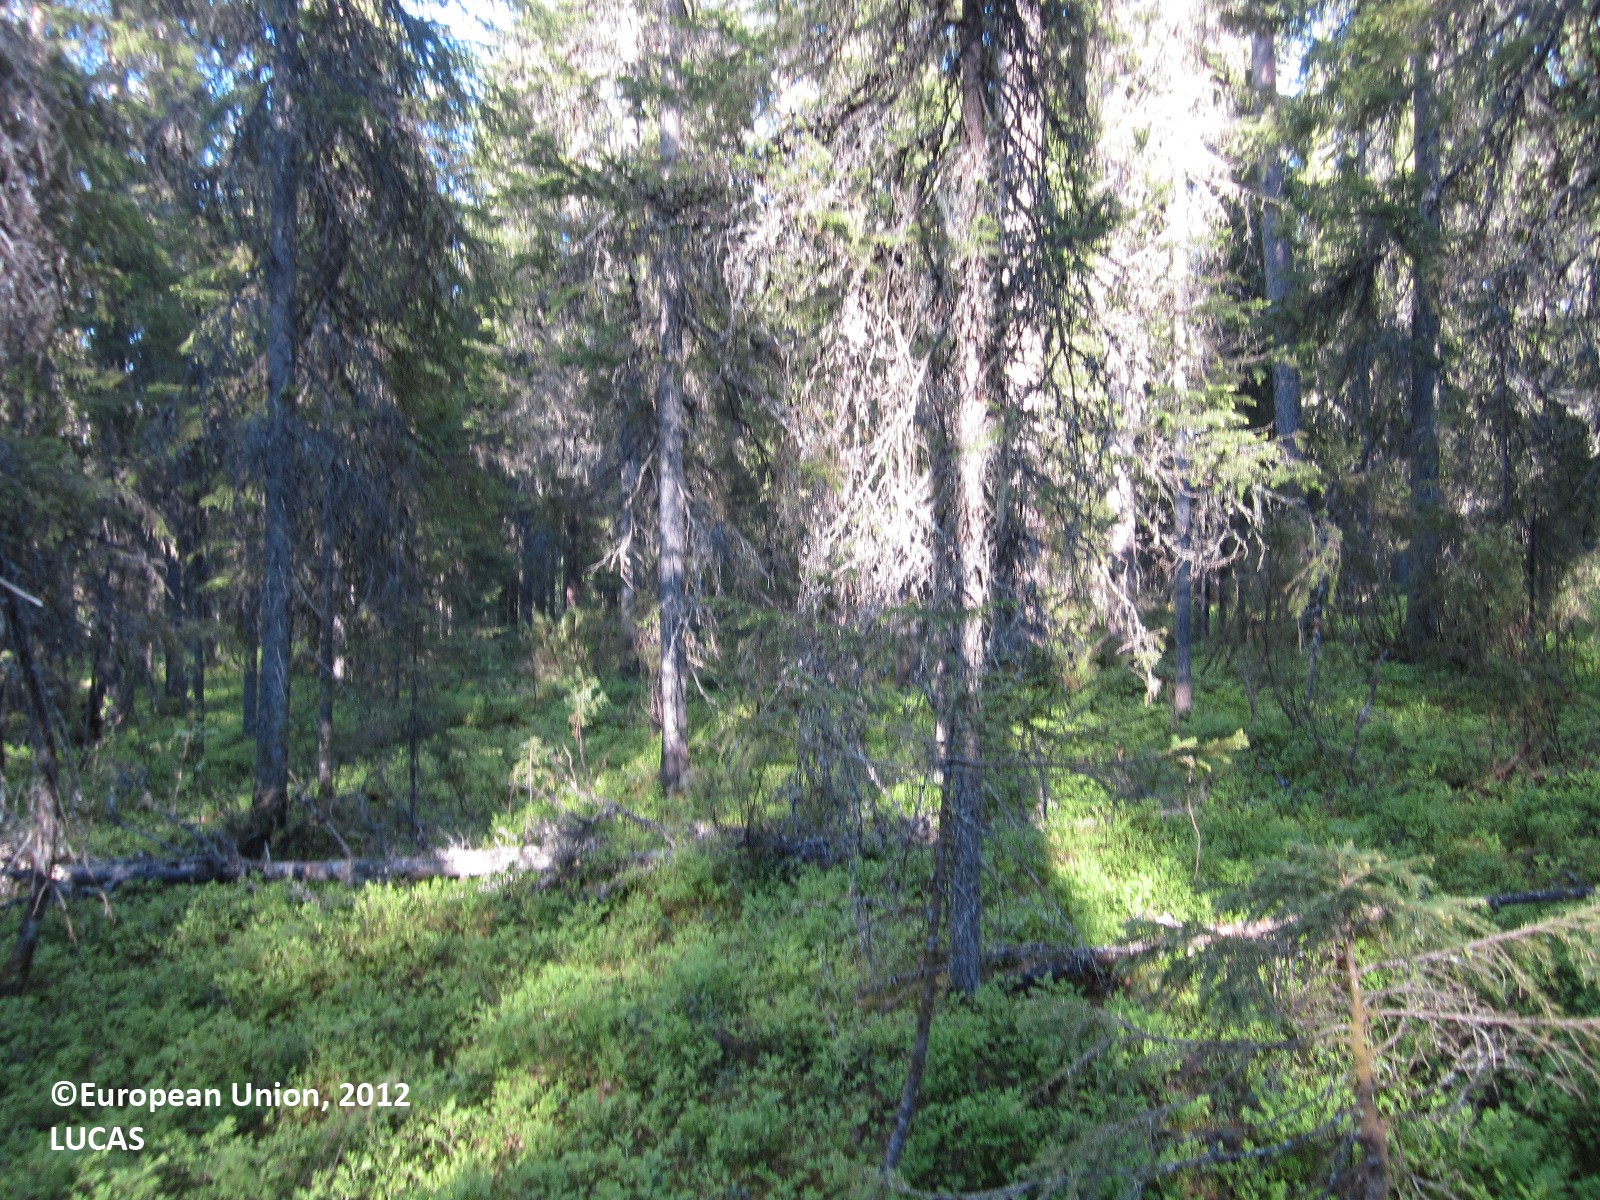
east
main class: Woodland
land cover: Spruce dominated coniferous woodland
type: boreal forest
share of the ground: > 75 %
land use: Forestry
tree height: > 5 m
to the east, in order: Spruce dominated coniferous woodland; Shrubland with sparse tree cover; Ditches and canals; Abandoned hedges; Paved roads, cycling and walking lanes; Abandoned hedges; Ditches and canals; Spruce dominated coniferous woodland
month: June
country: FI
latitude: 64.7036
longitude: 28.7444
